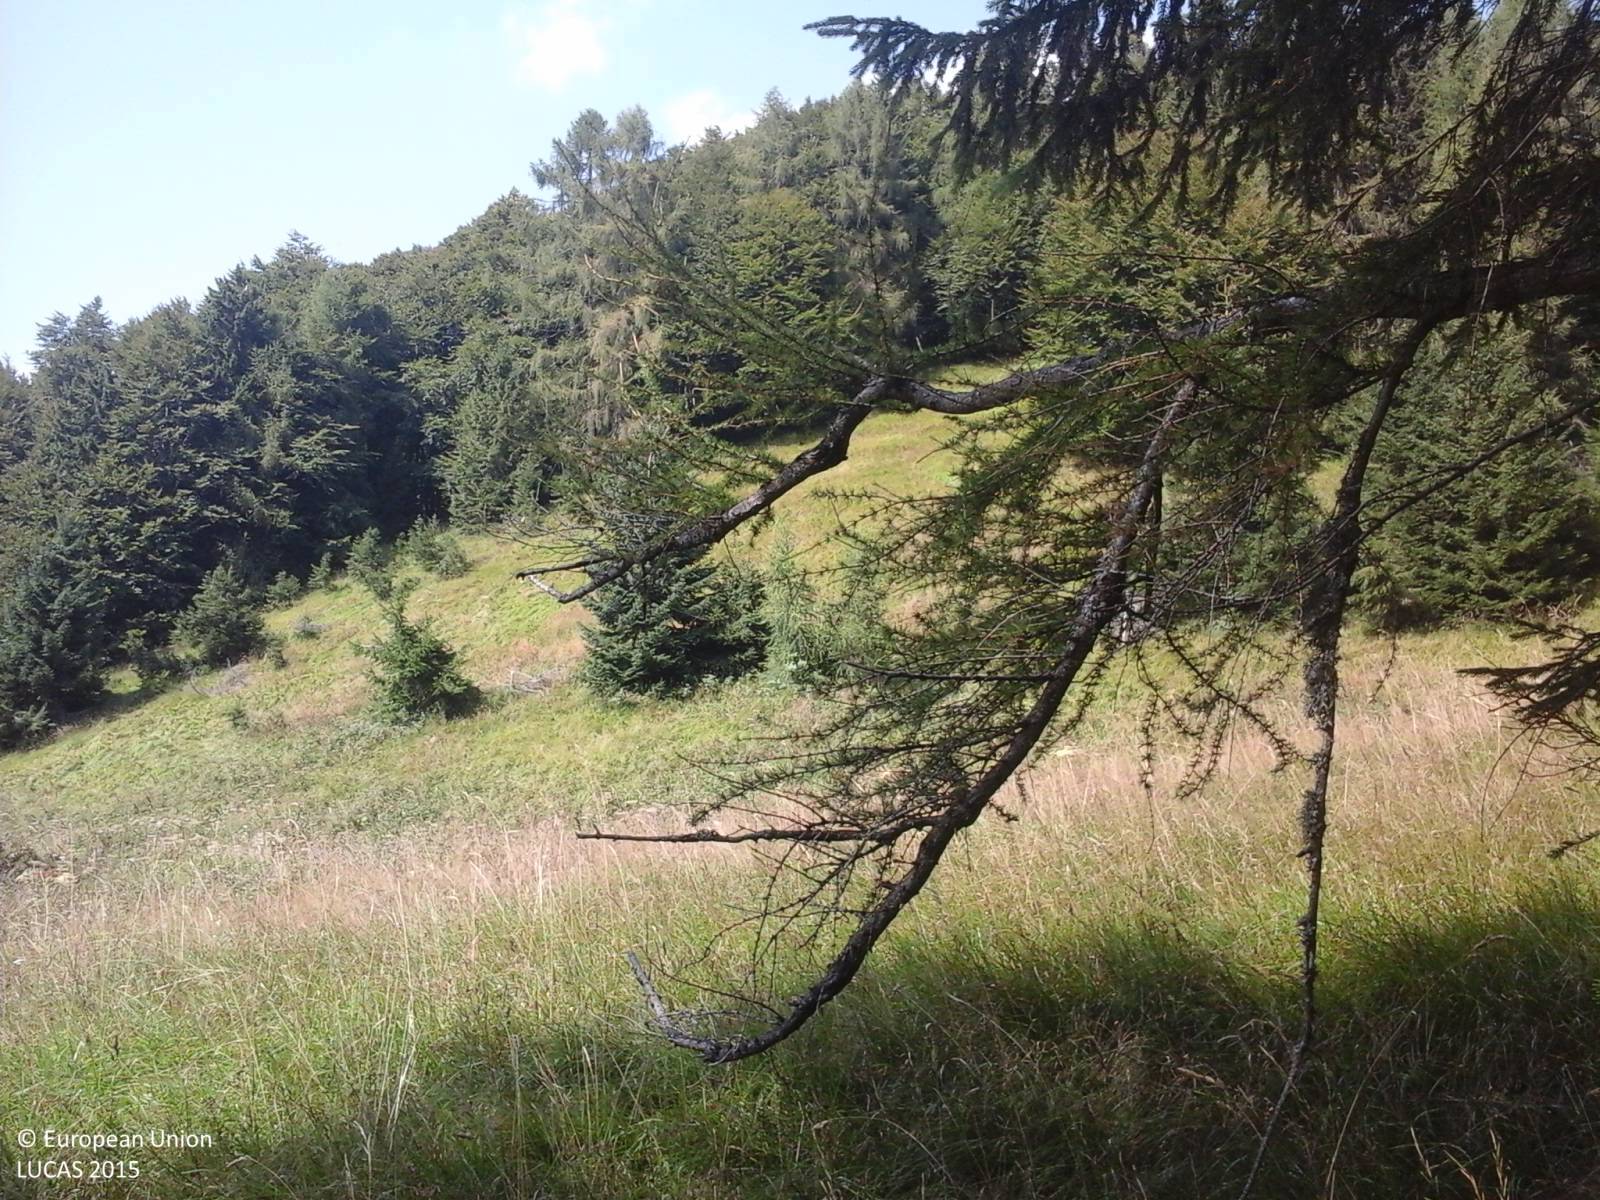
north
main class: Grassland
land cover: Grassland without tree/shrub cover
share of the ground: > 75 %
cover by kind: herbaceous plants 100 %
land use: Agriculture (excluding fallow land and kitchen gardens)
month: September
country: IT
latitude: 46.4602
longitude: 12.7445
